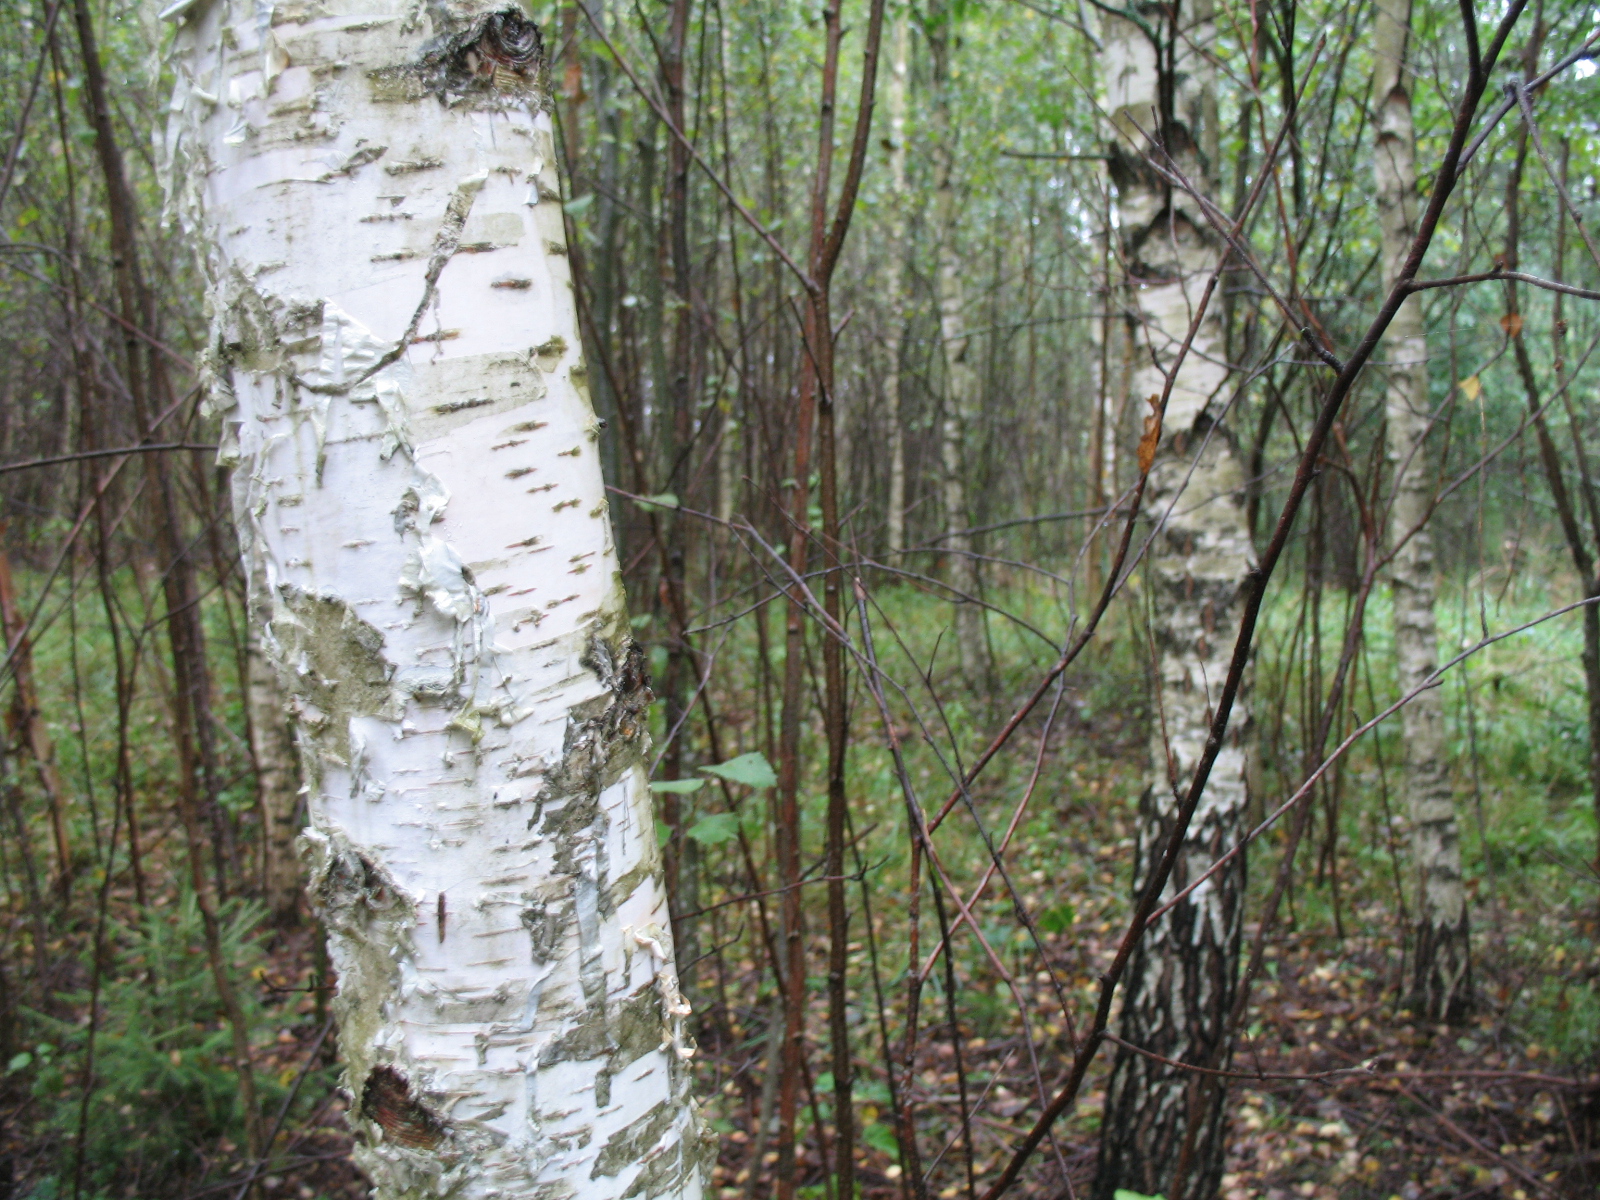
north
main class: Woodland
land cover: Broadleaved woodland
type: non-riverine alder, birch or aspen forest
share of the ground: 50 - 75 %
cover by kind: broadleaved forest trees 70 %, herbaceous plants 30 %
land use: Forestry
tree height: > 5 m
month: September
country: LV
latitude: 56.0174
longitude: 25.8693
